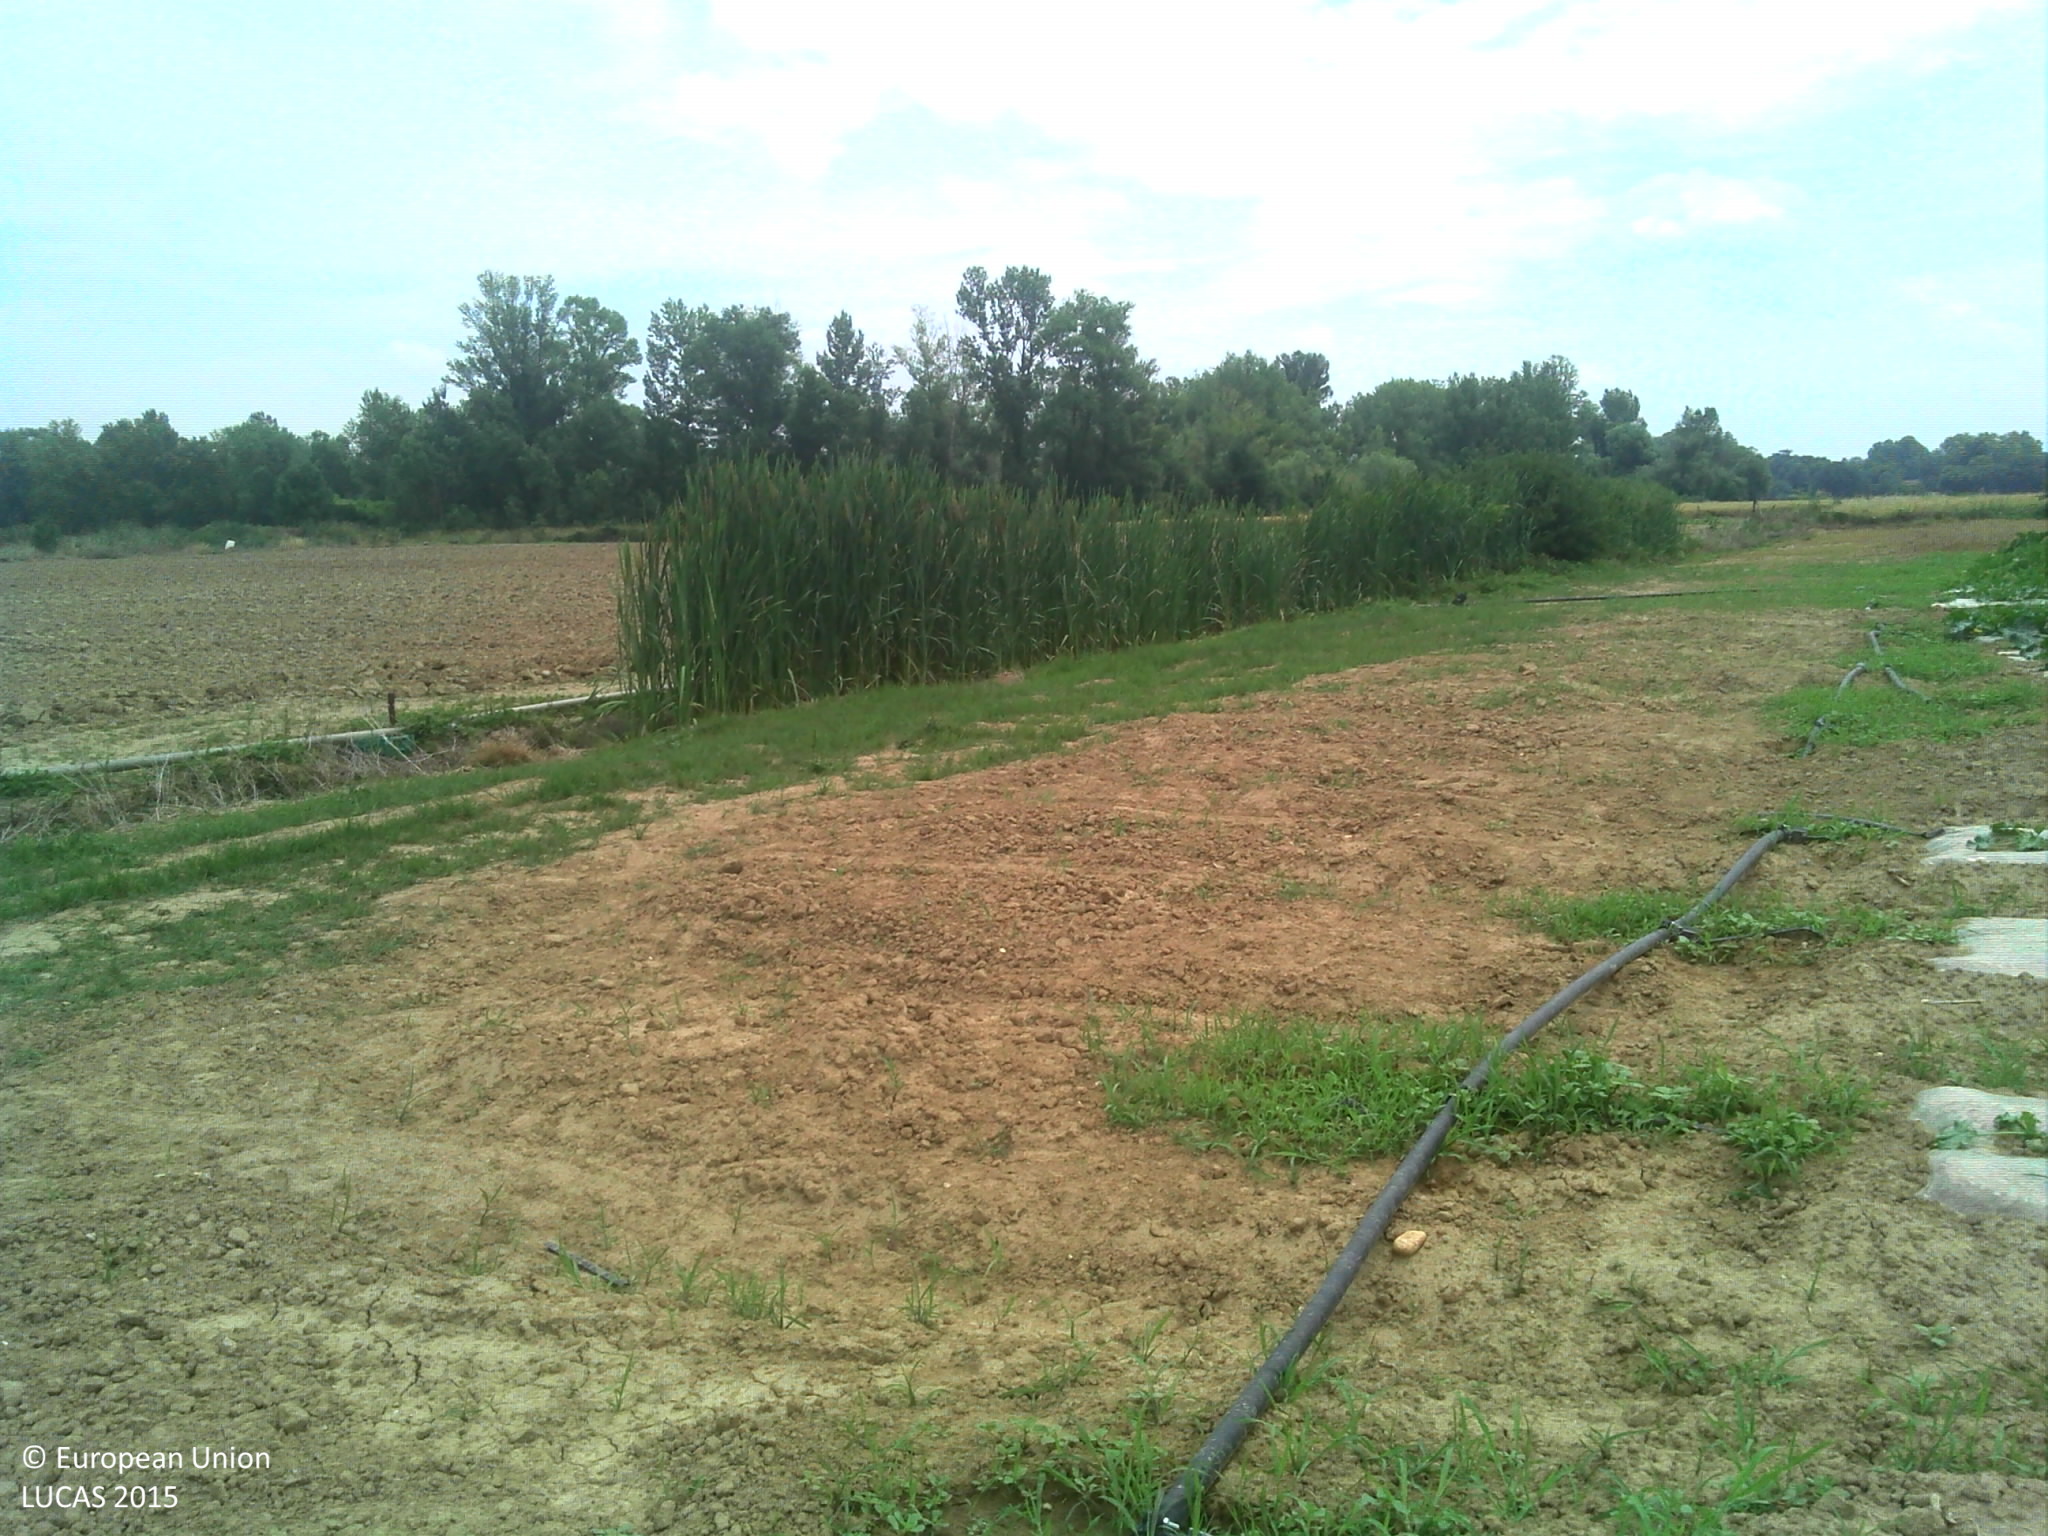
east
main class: Cropland
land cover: Other fresh vegetables
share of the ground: < 10 %
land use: Agriculture (excluding fallow land and kitchen gardens)
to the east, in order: Other fresh vegetables; Grass margins; Shruby margins; Ditches and canals; Grass margins; Other bare soil; Fences; Abandoned hedges; Grass margins; Broadleaved woodland; Inland fresh water bodies
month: June
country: FR
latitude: 43.5991
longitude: 2.1392
